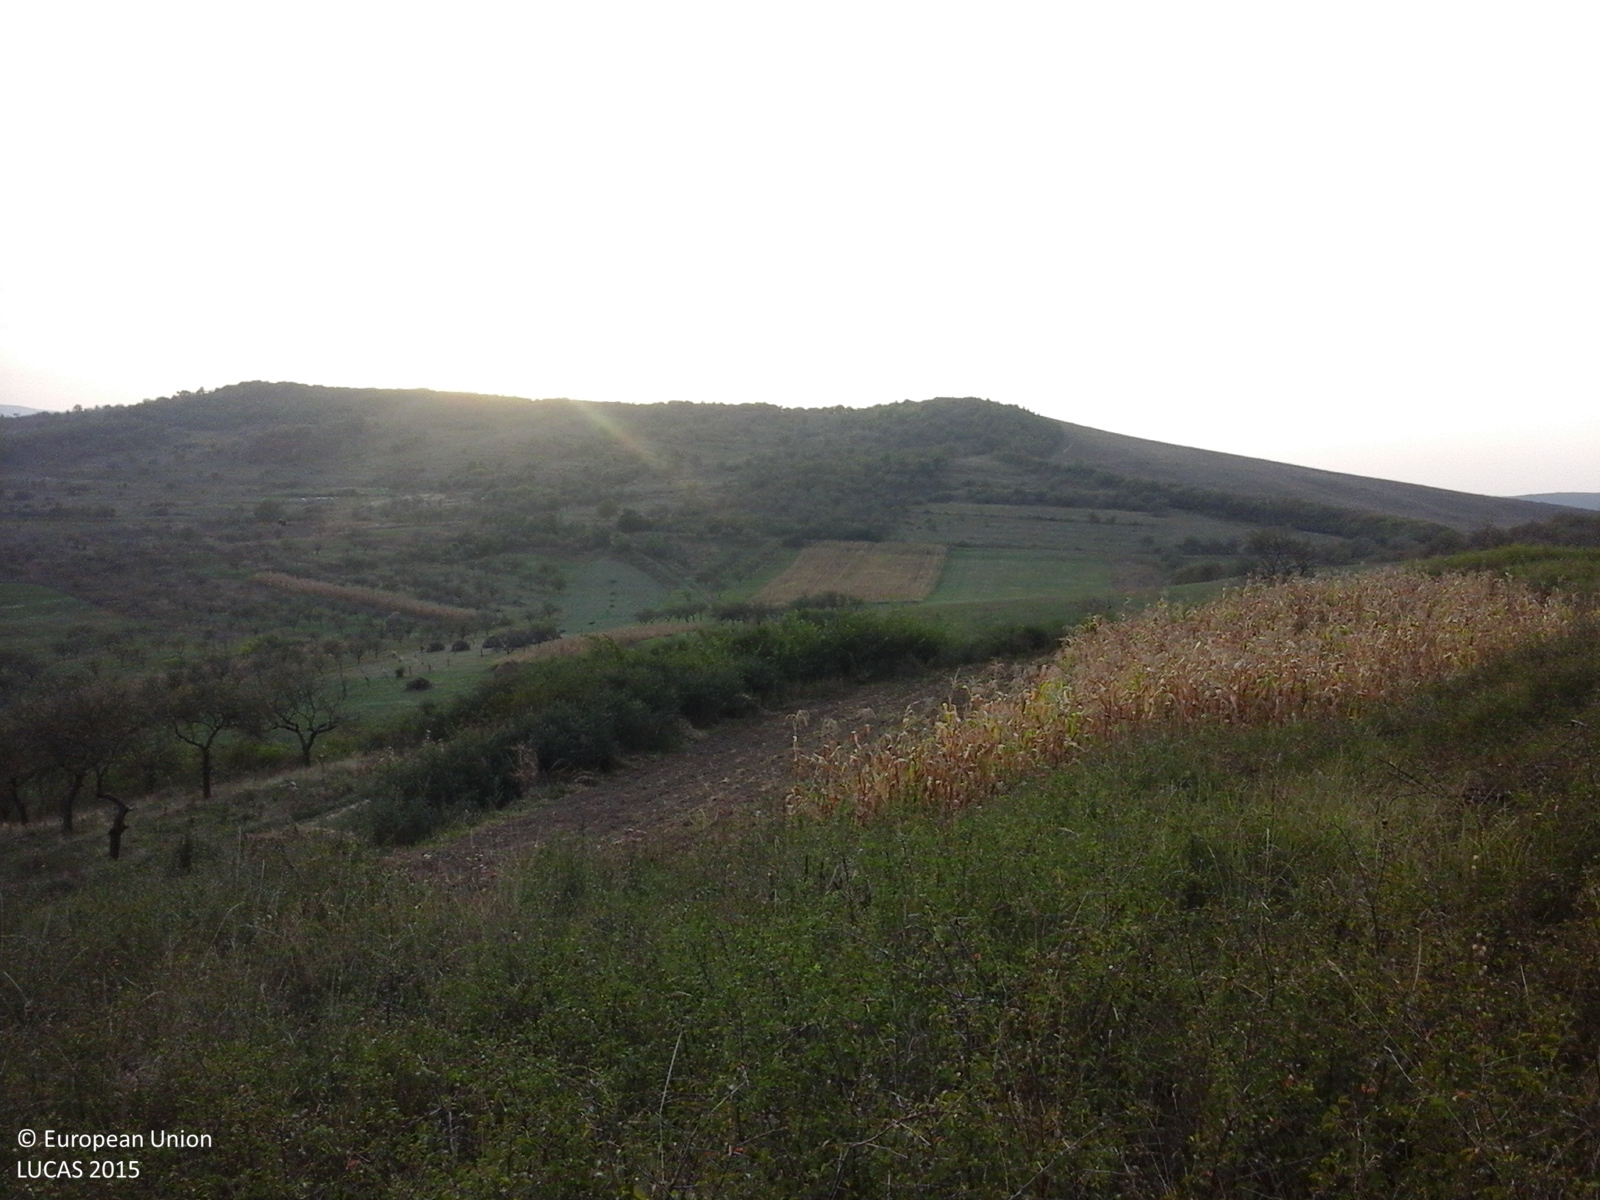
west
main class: Shrubland
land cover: Shrubland without tree cover
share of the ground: > 75 %
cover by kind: shrubs 100 %
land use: Semi-natural and natural areas not in use
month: September
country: RO
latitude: 47.1245
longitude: 23.8530
